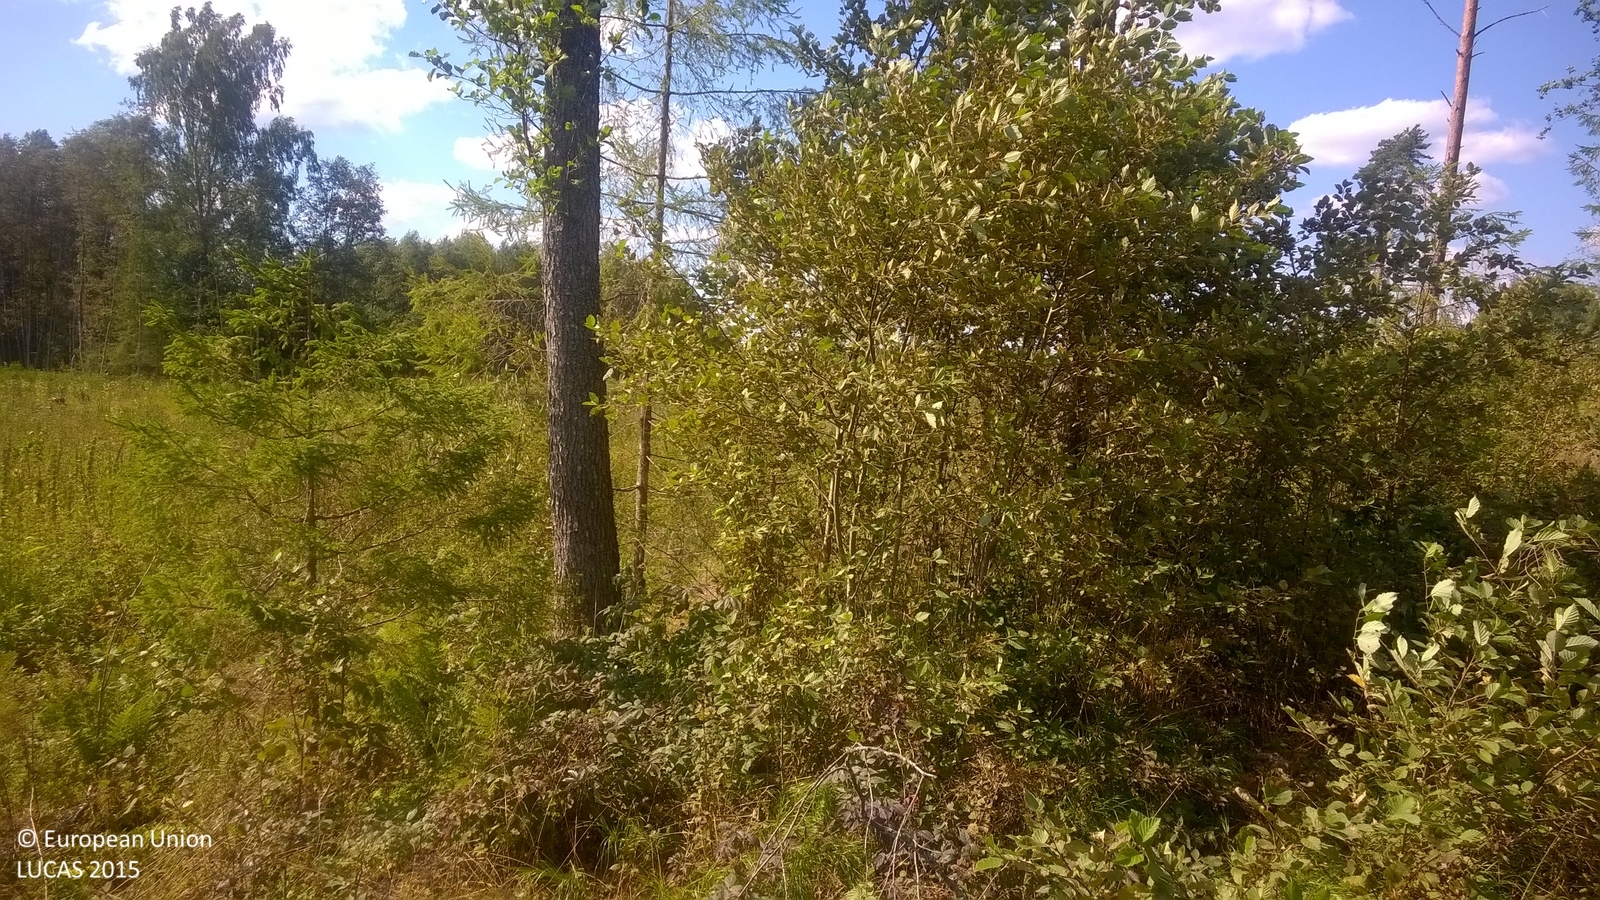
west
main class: Grassland
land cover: Grassland with sparse tree/shrub cover
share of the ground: > 75 %
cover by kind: herbaceous plants 85 %, shrubs 10 %, broadleaved forest trees 5 %
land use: Forestry
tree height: > 5 m
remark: Clear cut
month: August
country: LV
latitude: 57.8666
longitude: 25.7800
